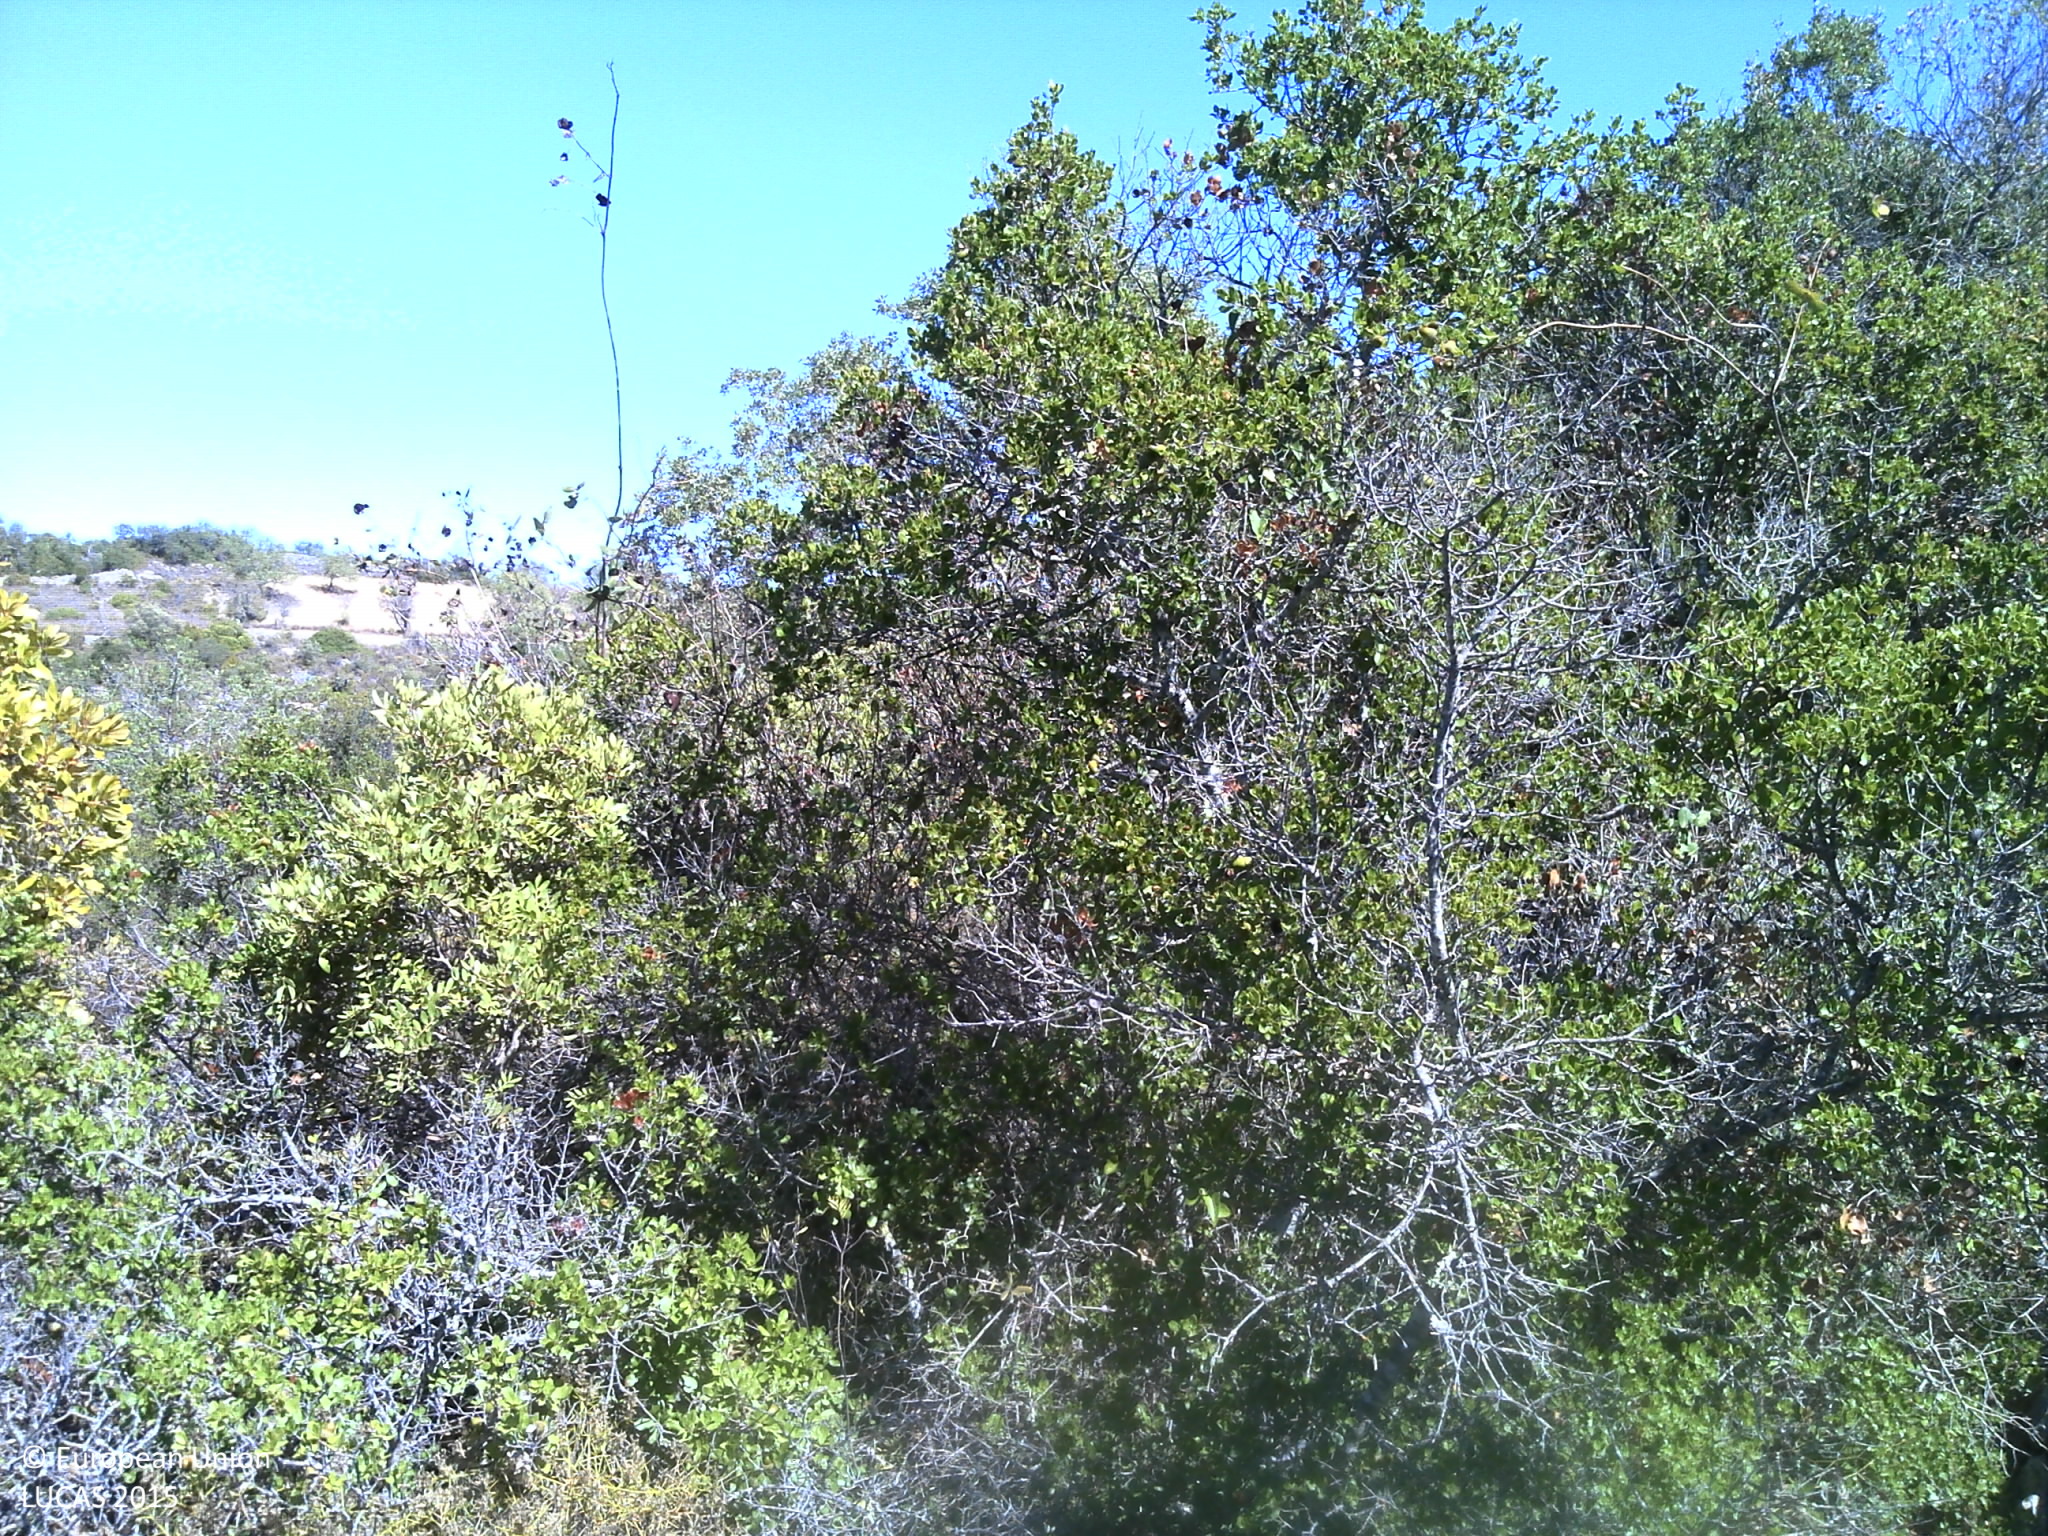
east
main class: Shrubland
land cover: Shrubland with sparse tree cover
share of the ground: 50 - 75 %
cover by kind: shrubs 70 %, unconsolidated bare surface 25 %, broadleaved forest trees 5 %
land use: Abandoned areas
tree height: < 5 m
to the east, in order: Shrubland with sparse tree cover; Dry stone walls; Shrubland with sparse tree cover; Paved roads, cycling and walking lanes; Shrubland with sparse tree cover; Grassland without tree/shrub cover; Nuts trees; Dry stone walls; Tracks; Dry stone walls; Shrubland with sparse tree cover; Tracks; Shruby margins; Dry stone walls; Shrubland with sparse tree cover
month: September
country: PT
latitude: 37.1686
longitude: -8.1600
